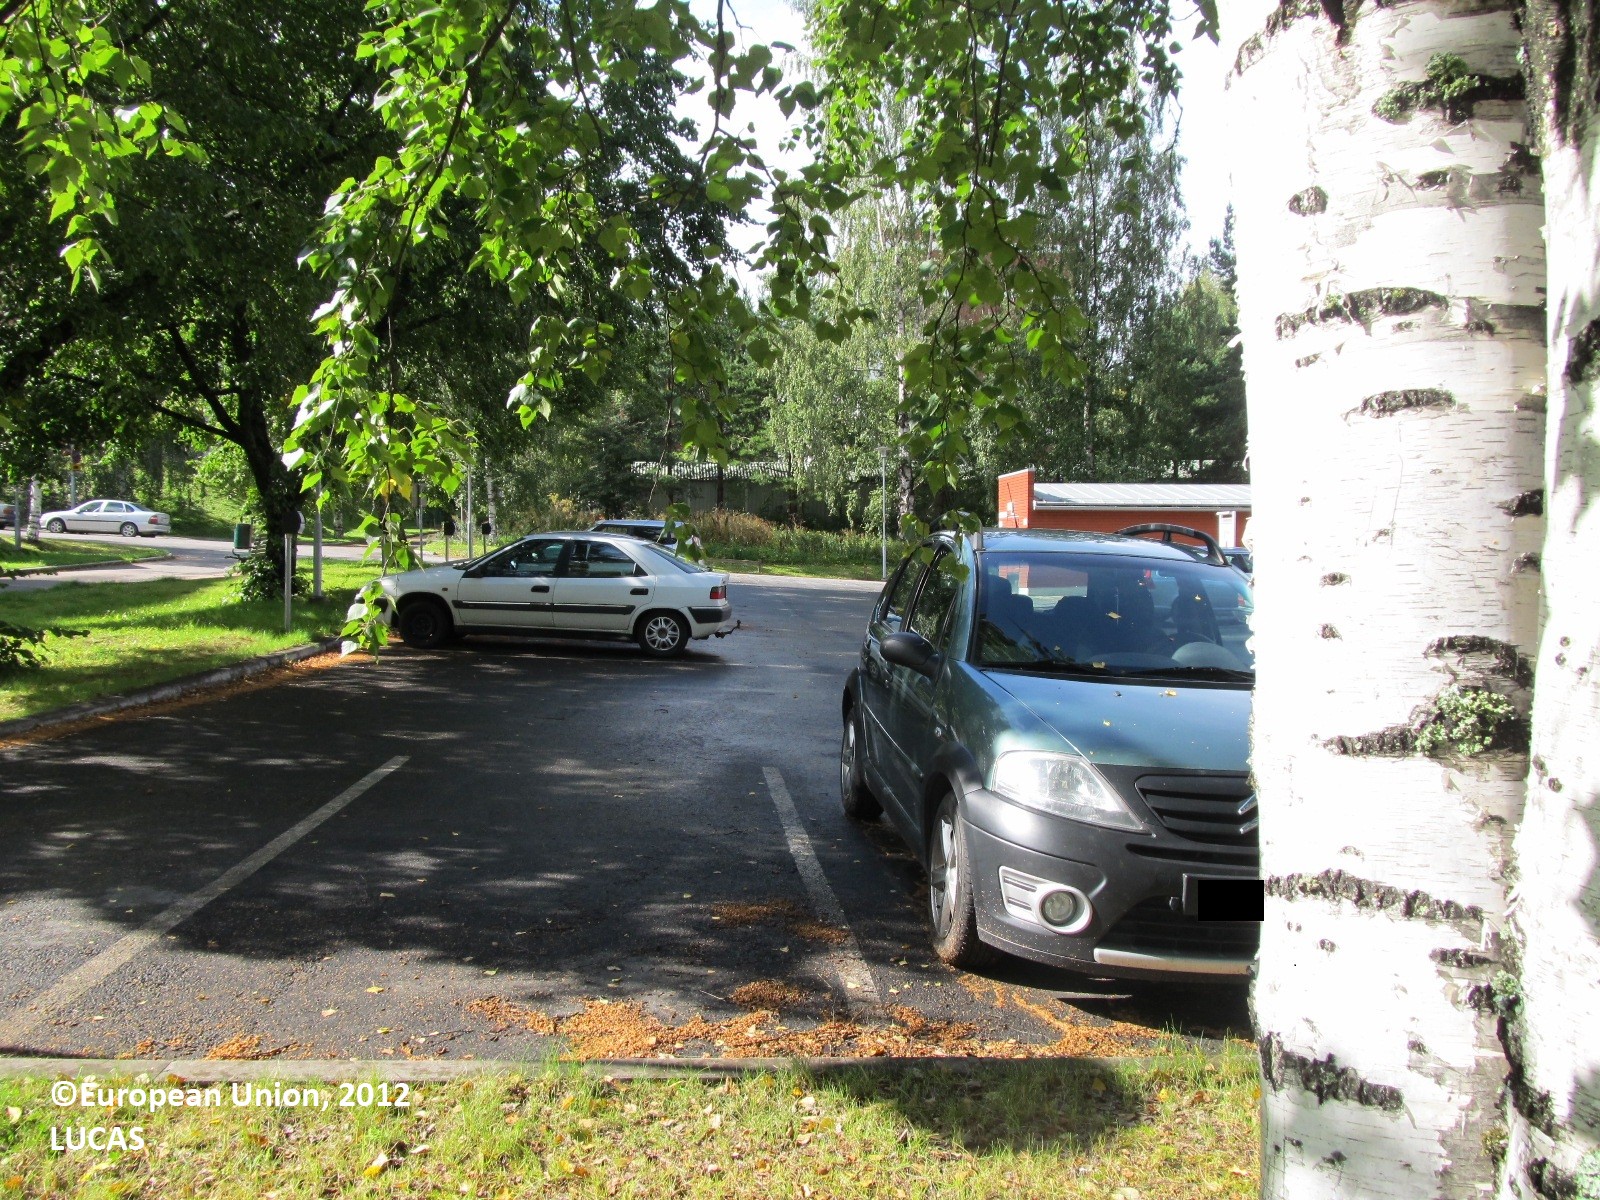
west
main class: Woodland
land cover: Broadleaved woodland
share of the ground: 10 - 25 %
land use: Residential
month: August
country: FI
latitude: 62.9057
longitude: 27.7044
